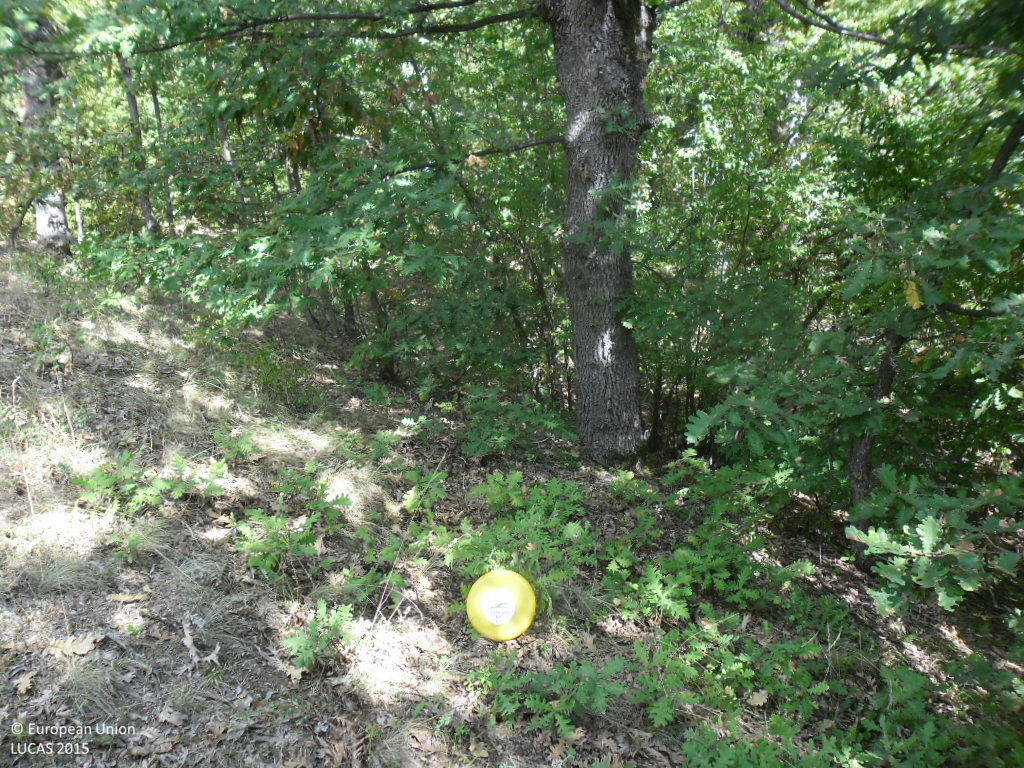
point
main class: Woodland
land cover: Broadleaved woodland
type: mesophytic deciduous forest
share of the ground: > 75 %
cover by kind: broadleaved forest trees 95 %, shrubs 5 %
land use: Forestry
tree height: > 5 m
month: September
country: BG
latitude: 41.8528
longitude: 22.9693
